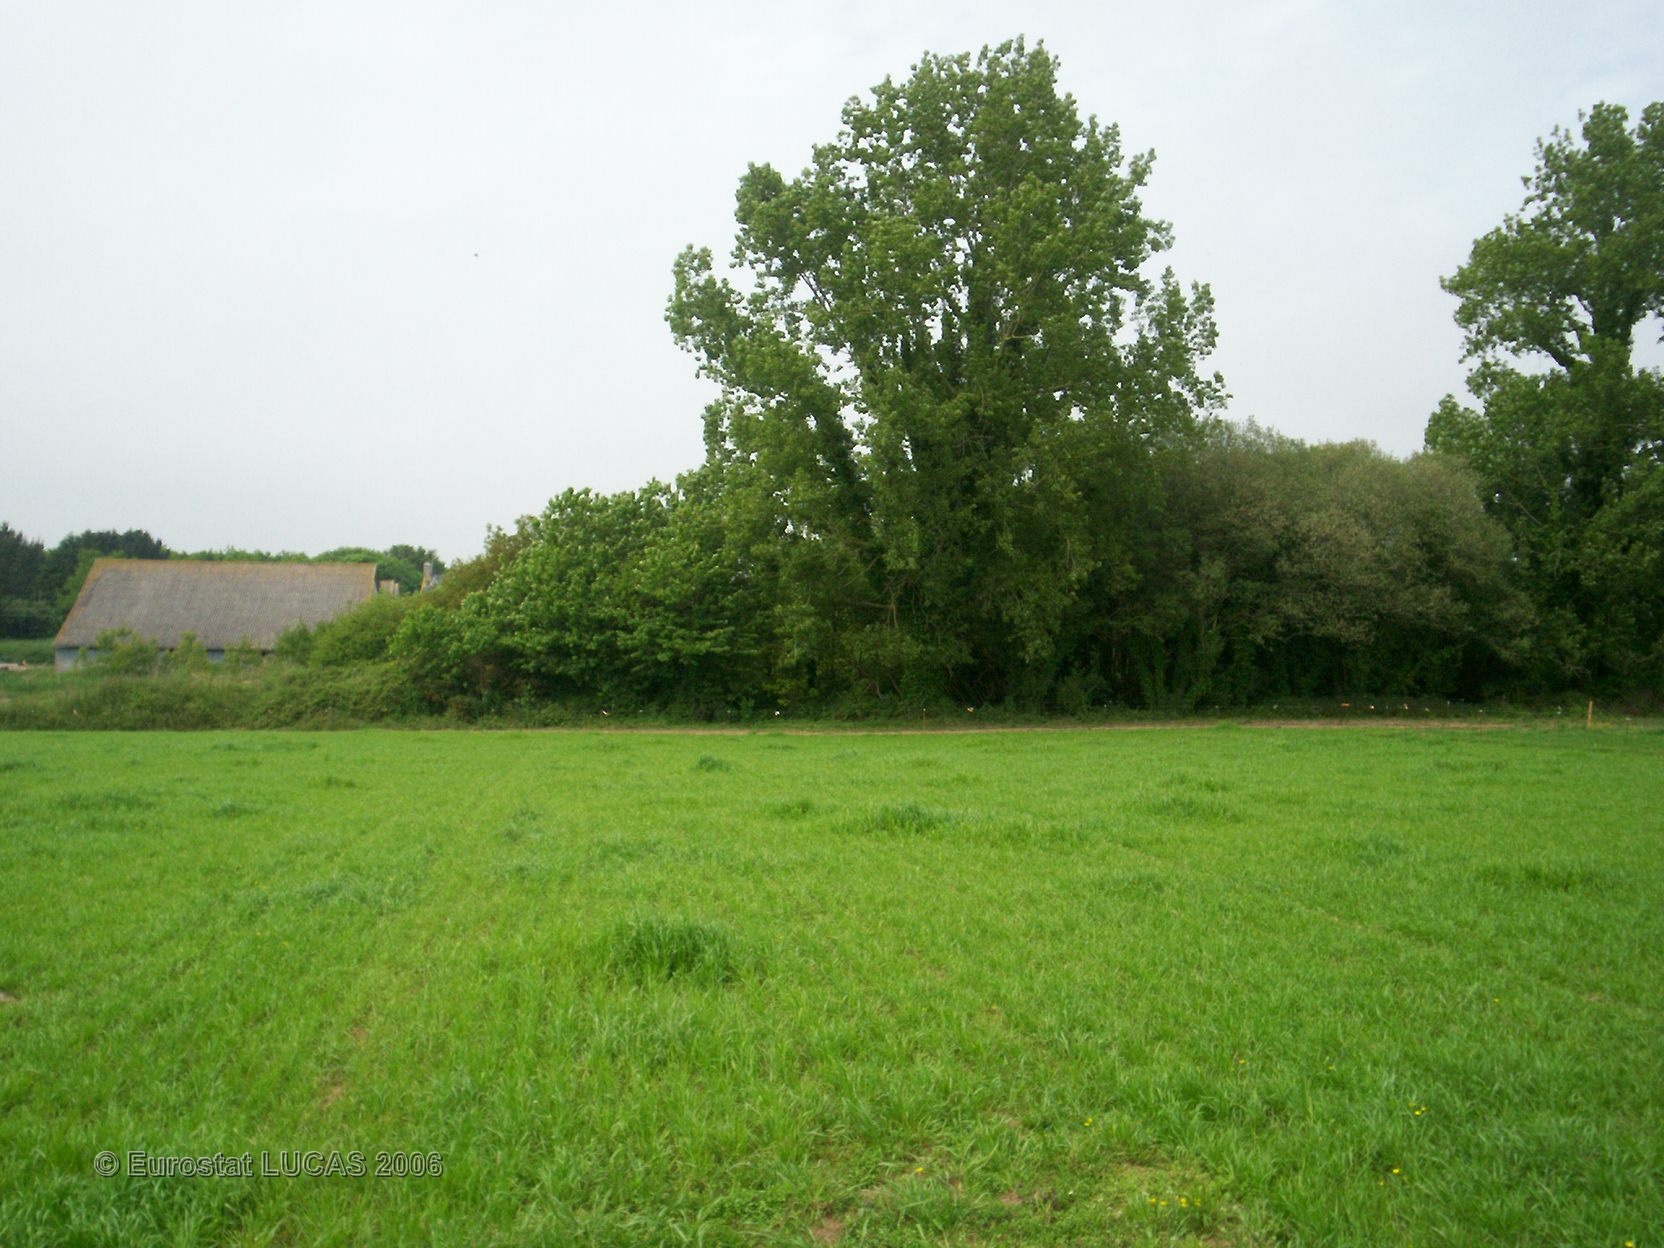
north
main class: Grassland
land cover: Grassland without tree/shrub cover
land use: Agriculture (excluding fallow land and kitchen gardens)
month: May
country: FR
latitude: 47.8184
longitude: -3.8522
